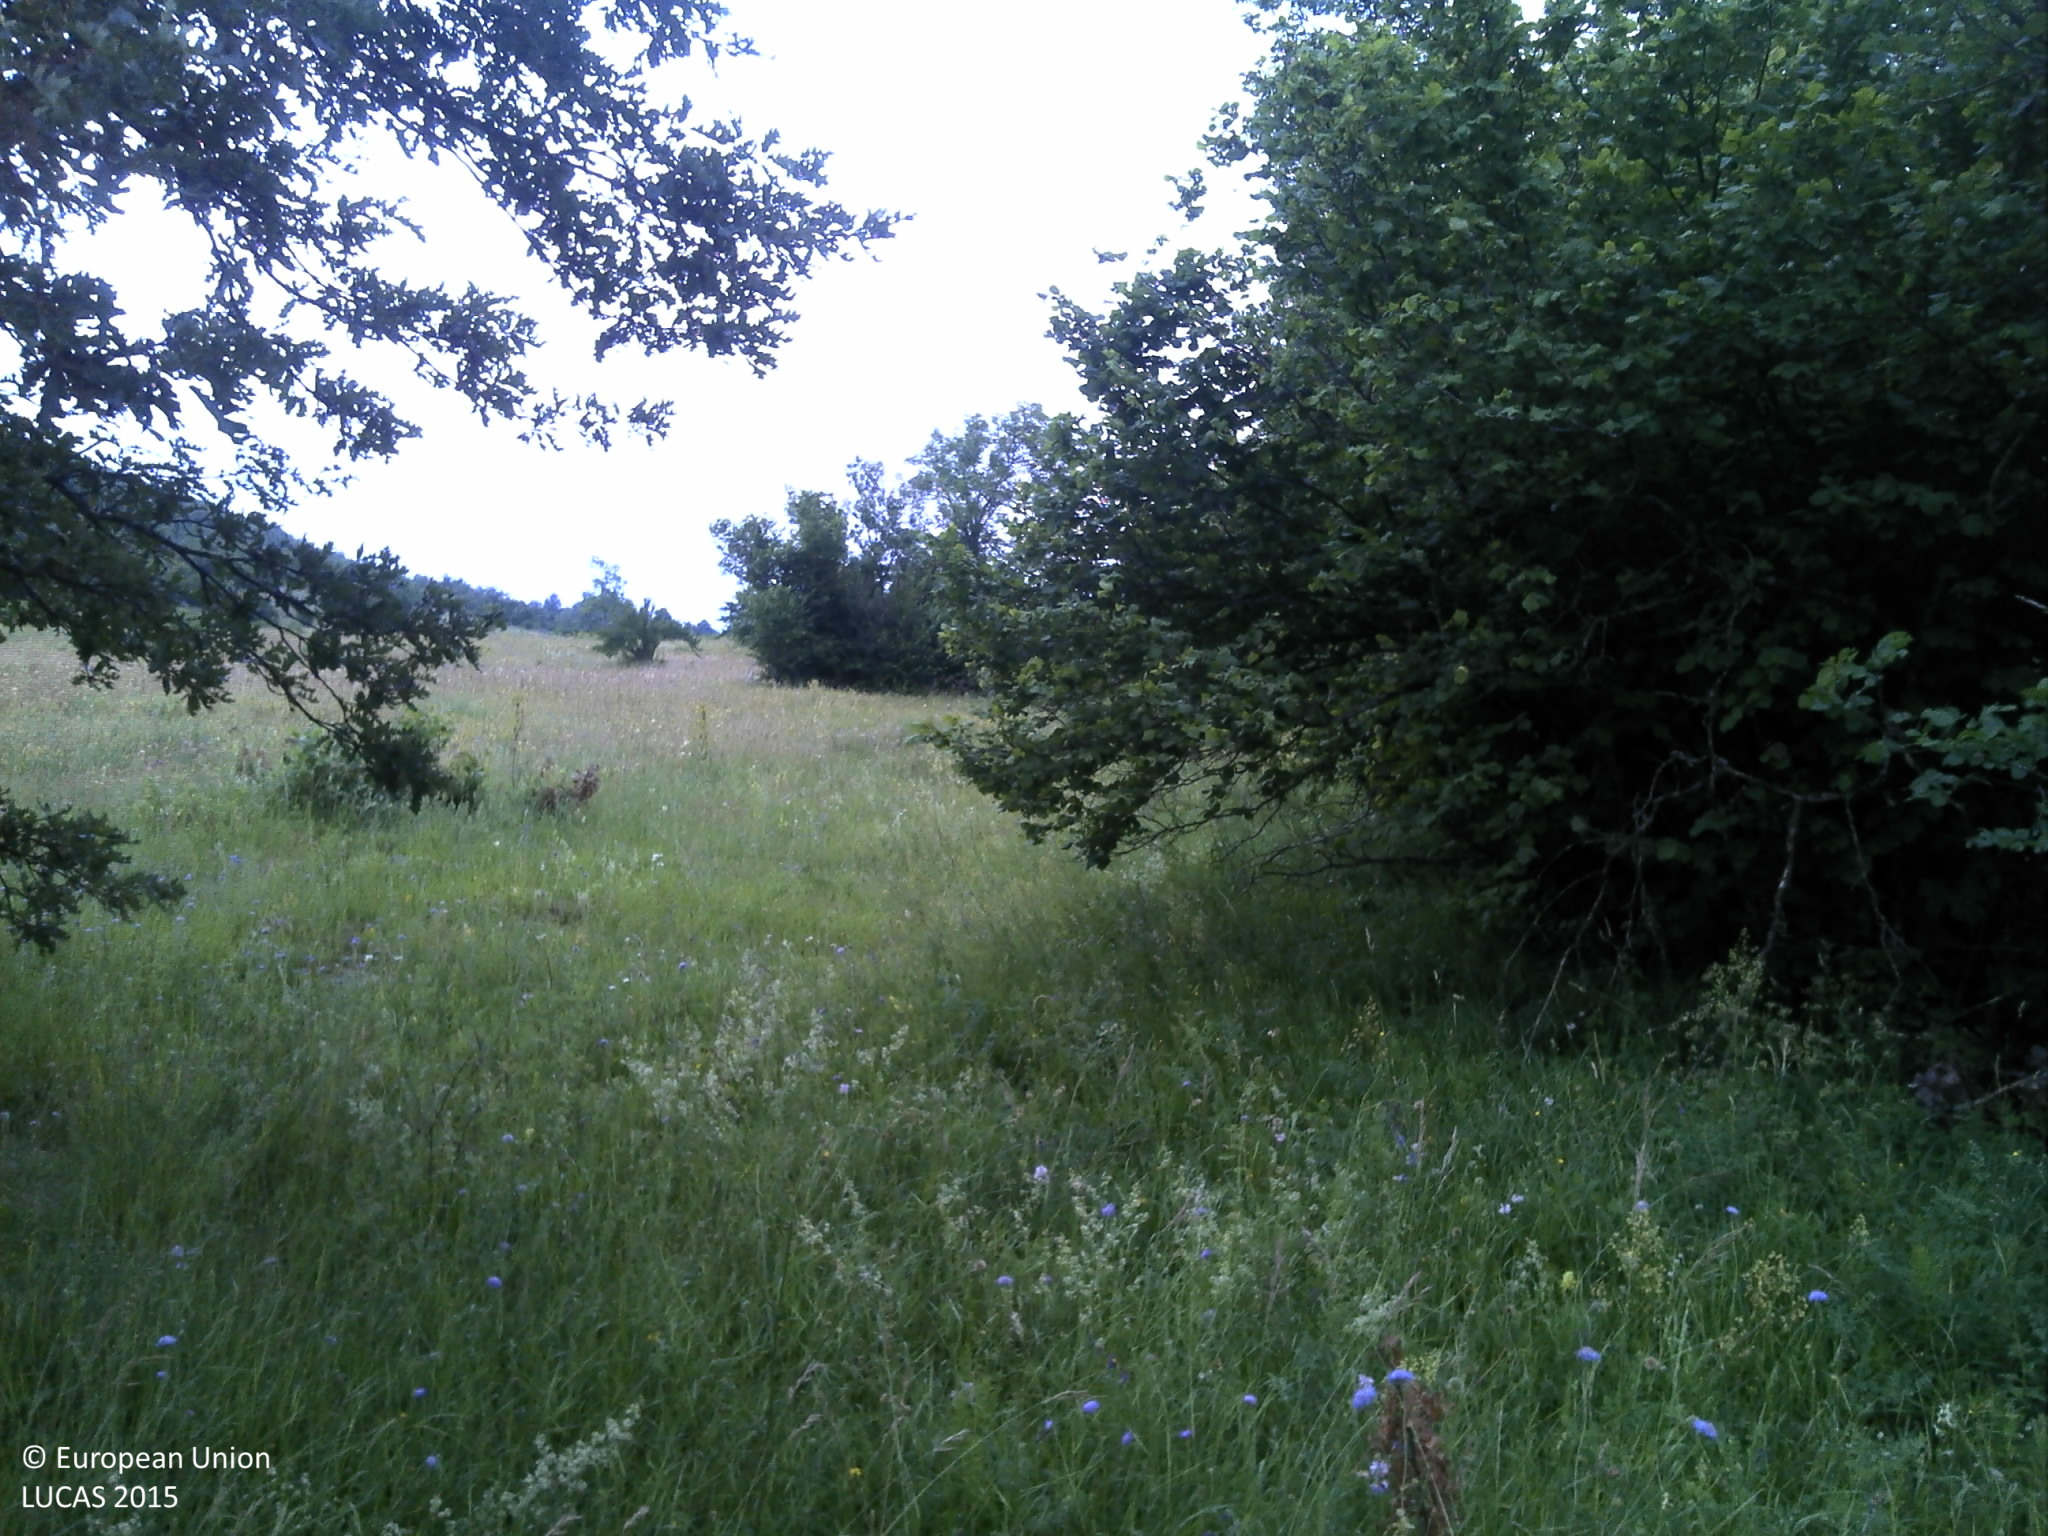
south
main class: Woodland
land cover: Broadleaved woodland
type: beech forest
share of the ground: > 75 %
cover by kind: broadleaved forest trees 90 %, herbaceous plants 10 %
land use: Semi-natural and natural areas not in use
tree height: > 5 m
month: June
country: HR
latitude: 44.3758
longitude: 15.6784
